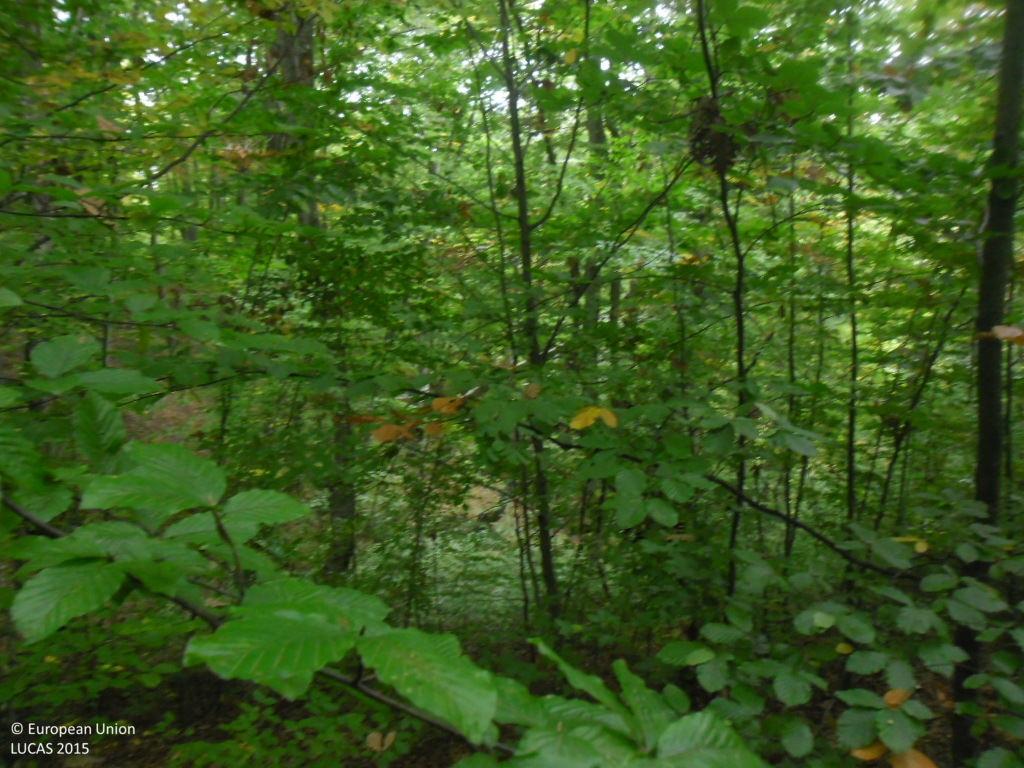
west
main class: Woodland
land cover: Broadleaved woodland
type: mountainous beech forest
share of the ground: > 75 %
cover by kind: broadleaved forest trees 95 %, unconsolidated bare surface 5 %
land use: Forestry
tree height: > 5 m
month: October
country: BG
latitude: 41.5614
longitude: 23.1014
